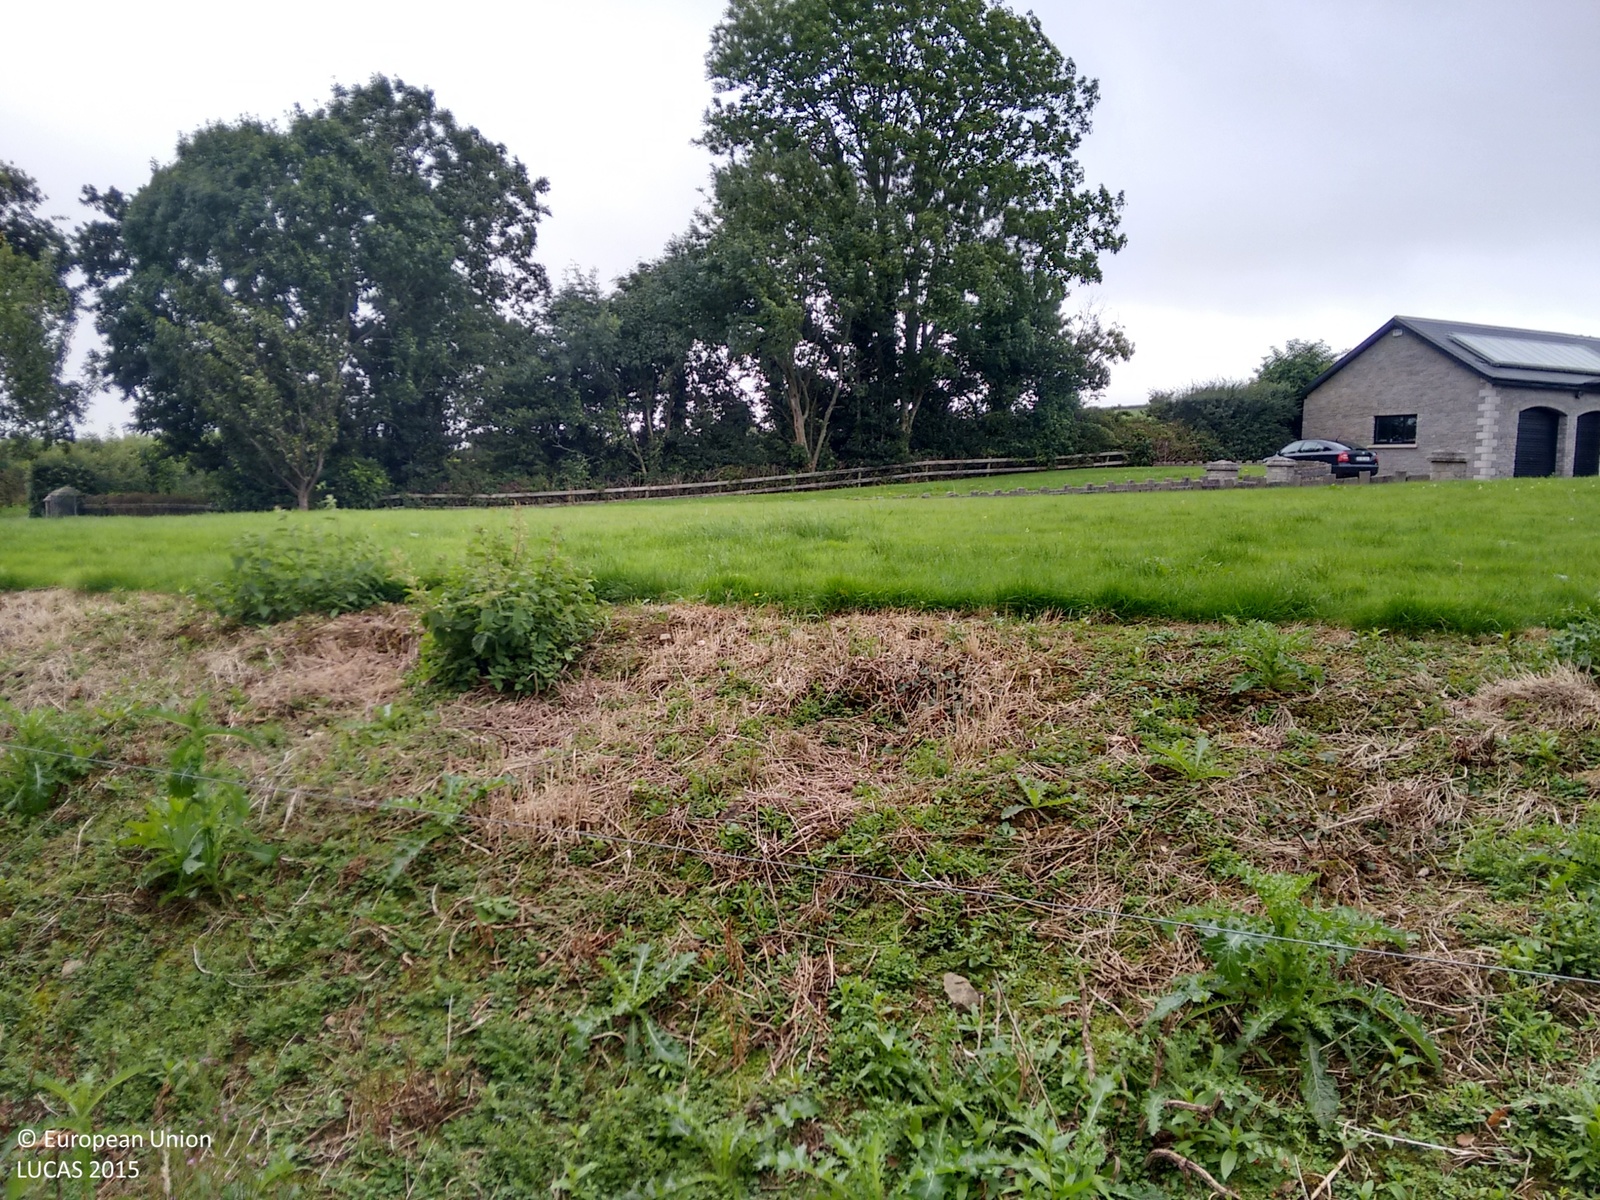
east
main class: Grassland
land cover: Grassland without tree/shrub cover
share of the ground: > 75 %
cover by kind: herbaceous plants 100 %
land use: Agriculture (excluding fallow land and kitchen gardens)
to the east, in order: Grassland without tree/shrub cover; Fences; Abandoned hedges; Fences; Grassland without tree/shrub cover; Fences; Abandoned hedges; Artificial constructions in urban areas; Barley
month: August
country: IE
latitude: 52.4472
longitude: -6.5946
